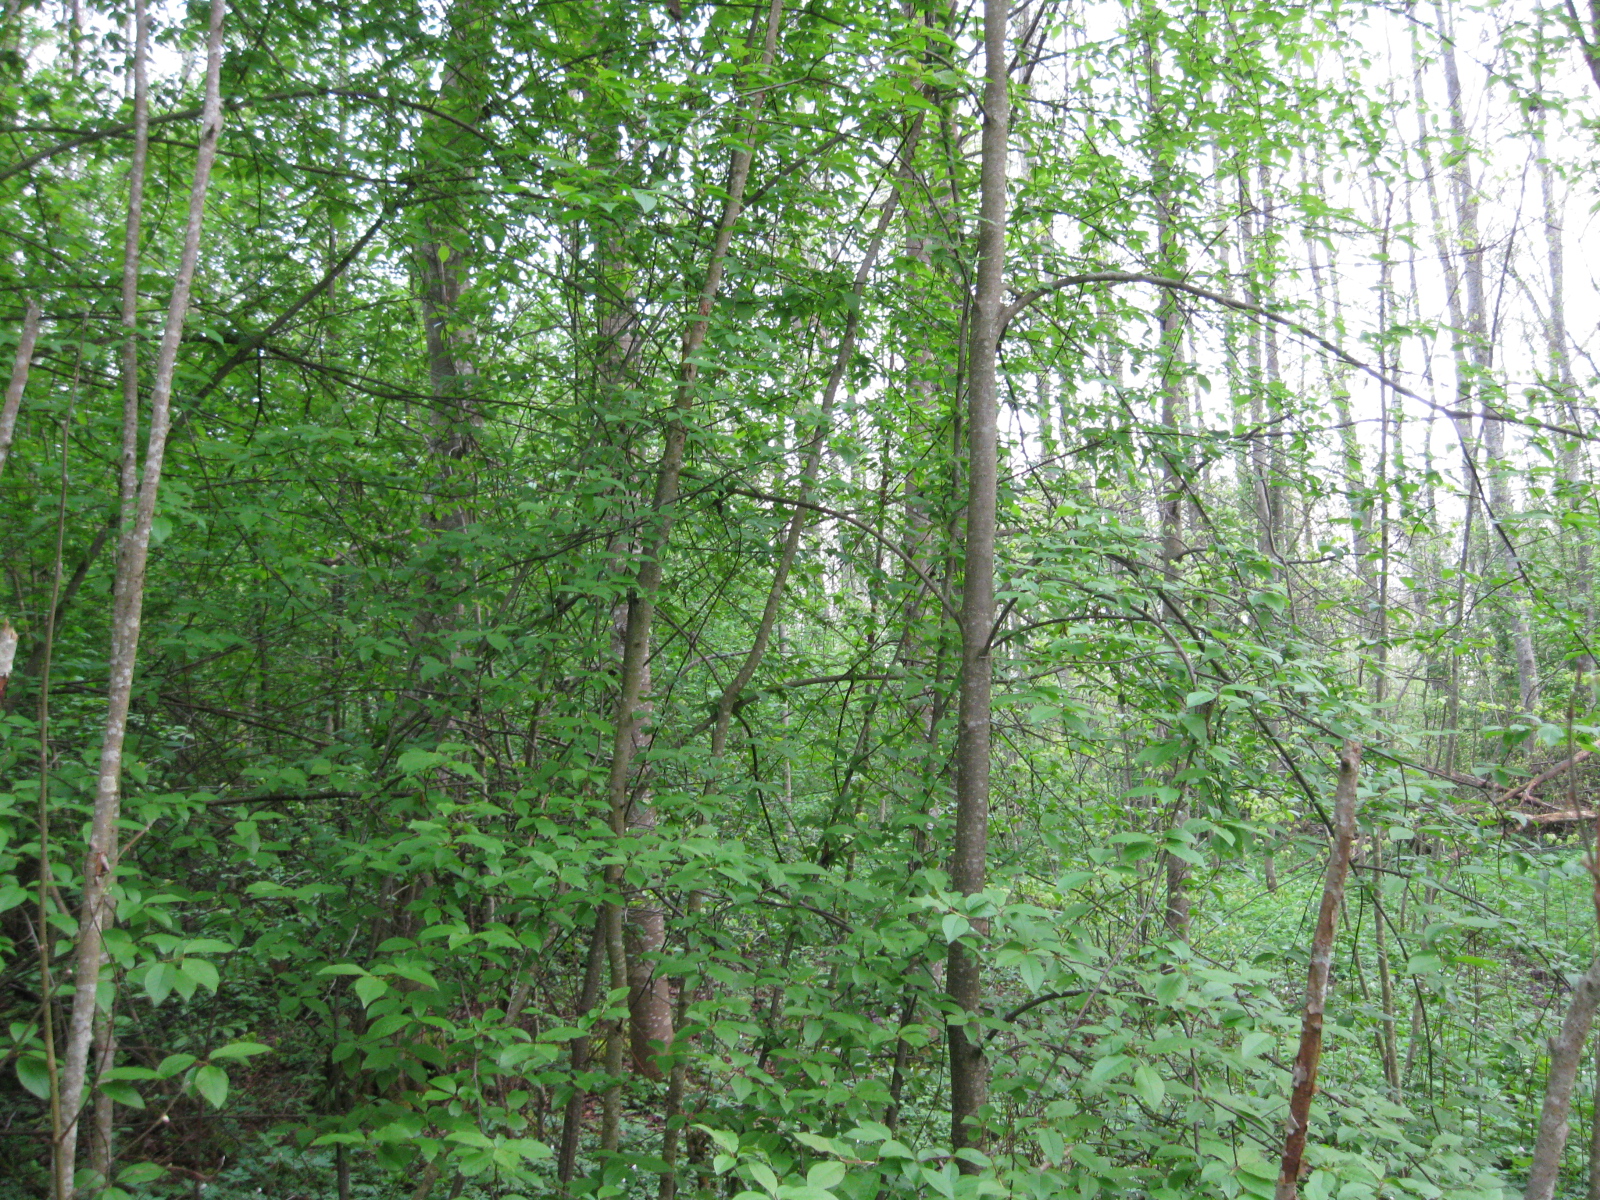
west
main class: Woodland
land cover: Broadleaved woodland
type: non-riverine alder, birch or aspen forest
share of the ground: > 75 %
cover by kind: broadleaved forest trees 85 %, herbaceous plants 10 %, lichens and mosses 5 %
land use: Forestry
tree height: > 5 m
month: May
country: LT
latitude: 56.2221
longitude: 24.4660
